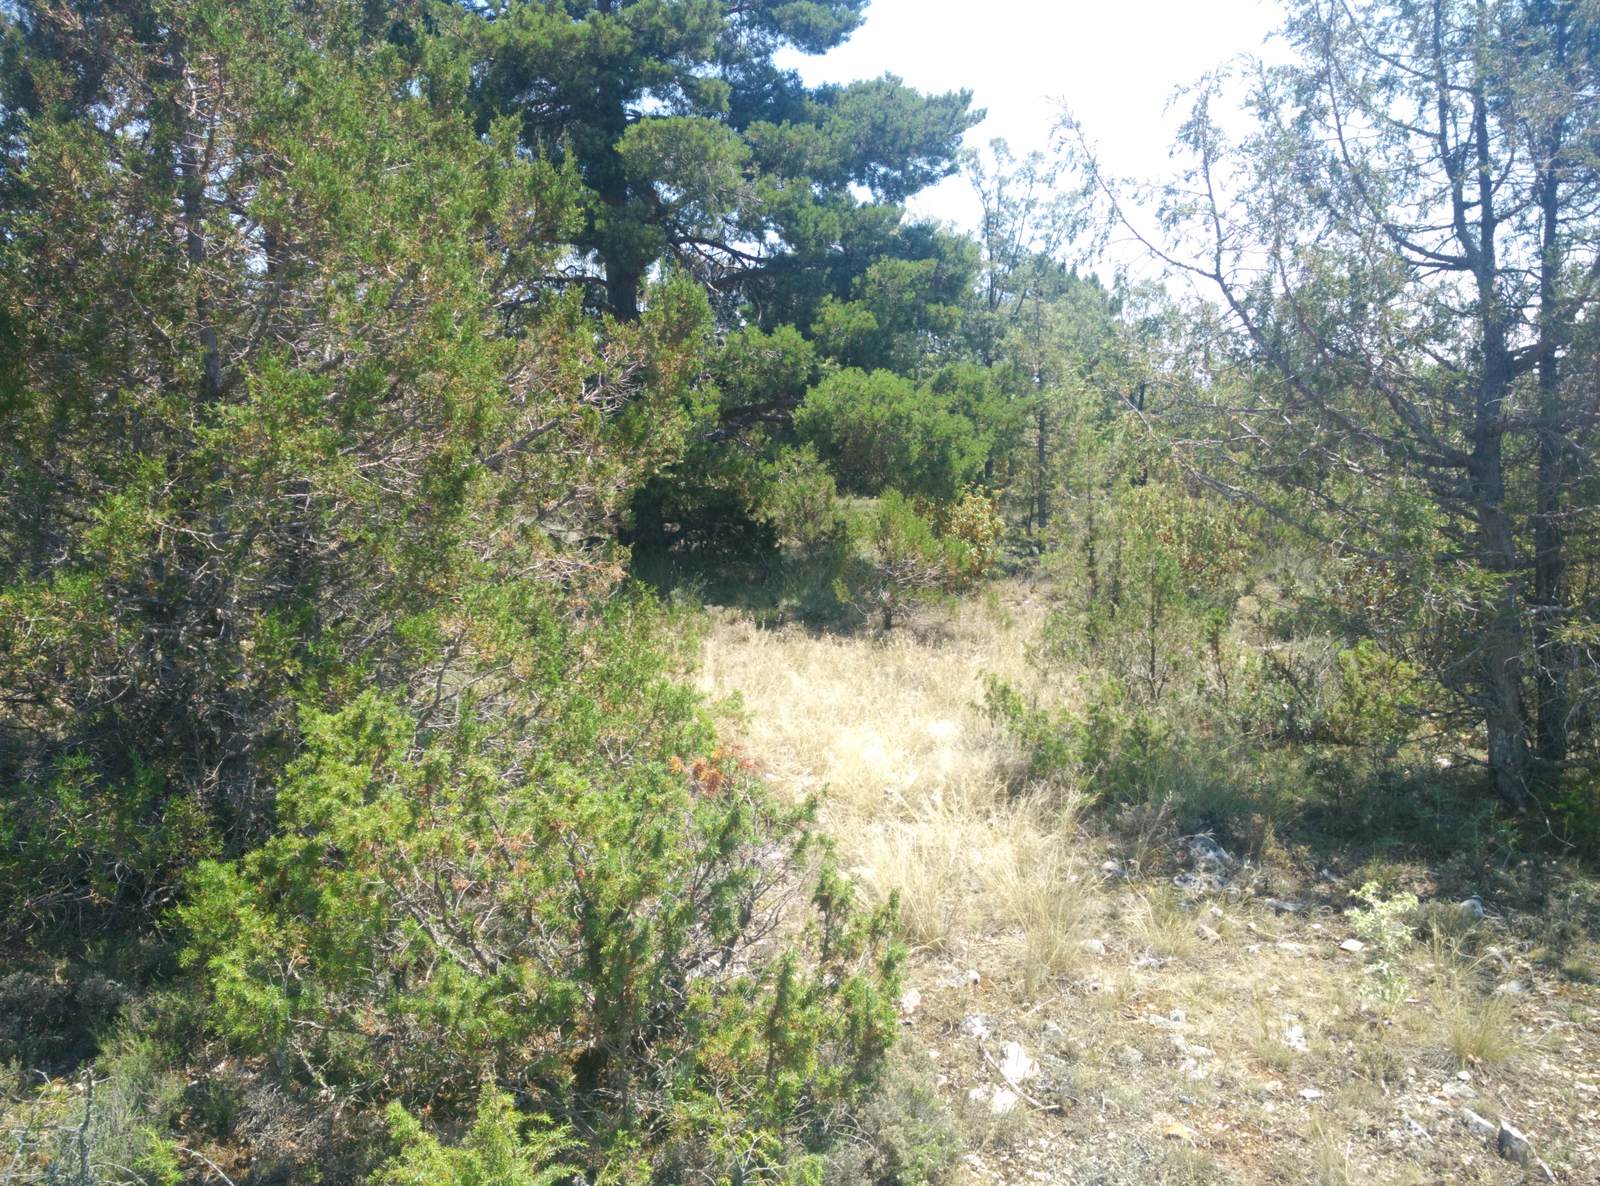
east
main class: Woodland
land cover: Other mixed woodland
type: coniferous forest of the mediterranean region
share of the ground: 25 - 50 %
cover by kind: unconsolidated bare surface 40 %, shrubs 25 %, coniferous forest trees 15 %, broadleaved forest trees 10 %, herbaceous plants 5 %, lichens and mosses 5 %
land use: Semi-natural and natural areas not in use
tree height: > 5 m
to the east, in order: Other mixed woodland
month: July
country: ES
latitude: 40.9368
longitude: -2.1283
